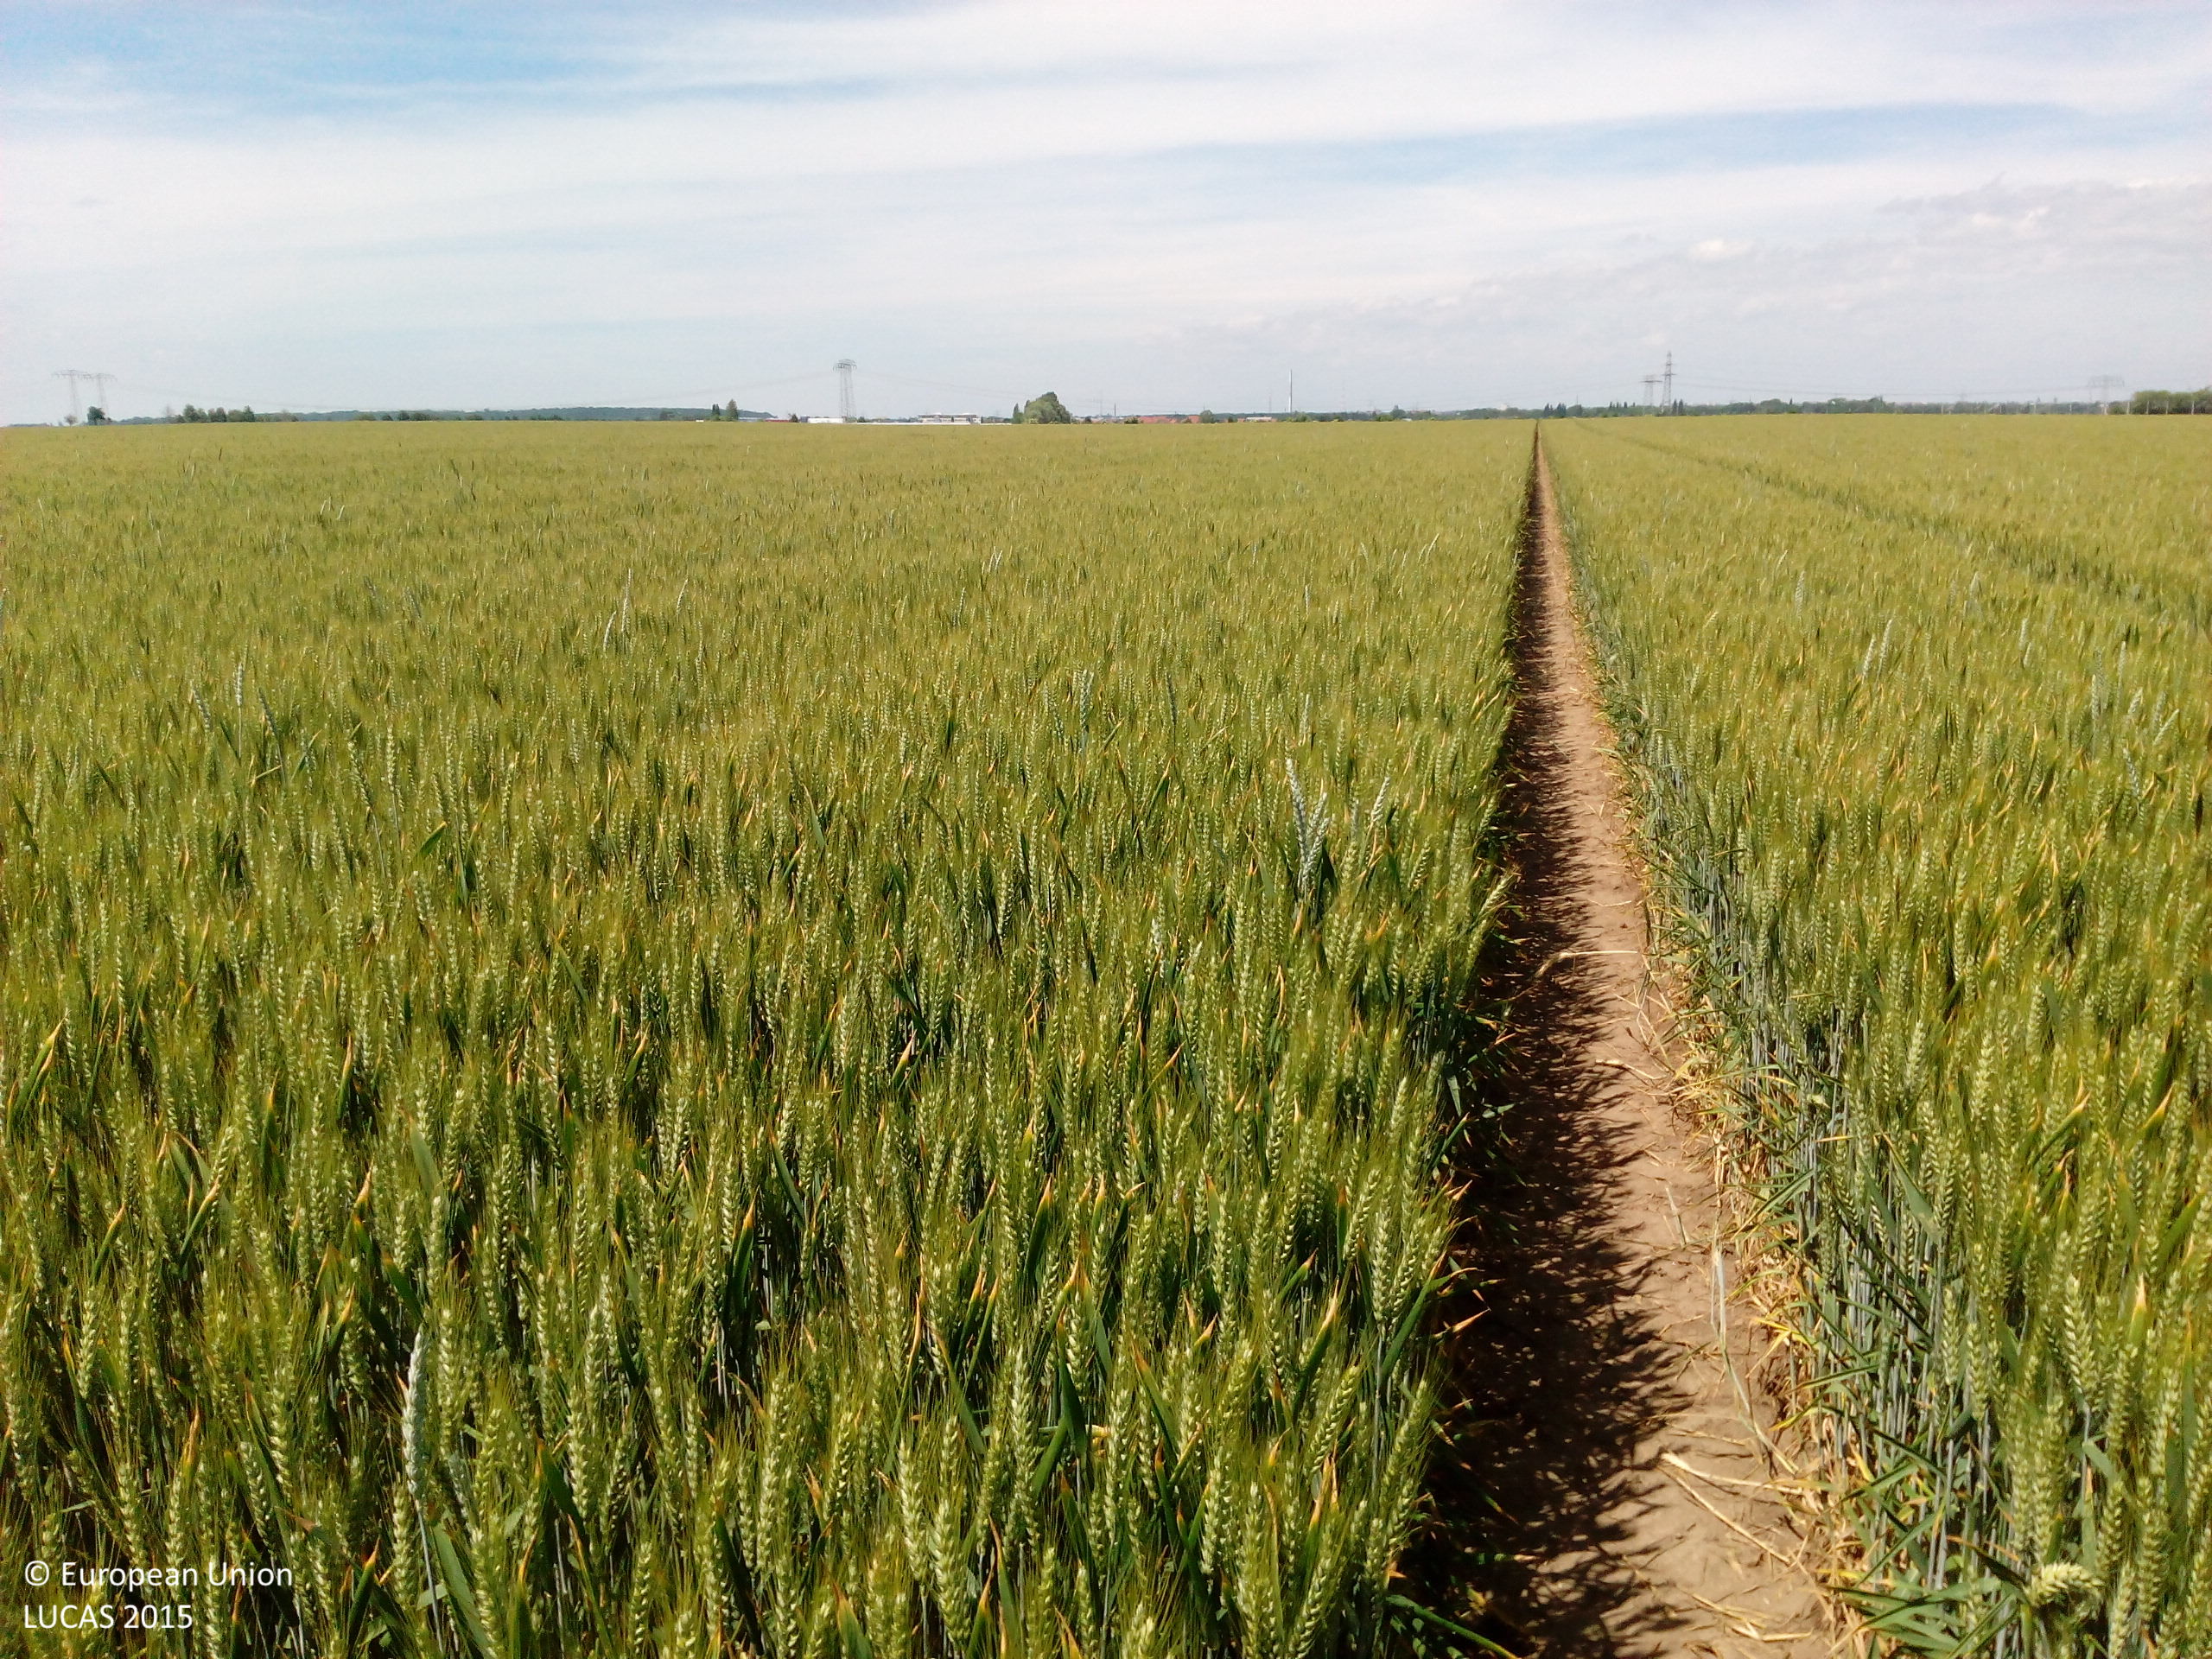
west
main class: Cropland
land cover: Rye
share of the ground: > 75 %
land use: Agriculture (excluding fallow land and kitchen gardens)
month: June
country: DE
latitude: 51.4421
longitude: 12.0858
